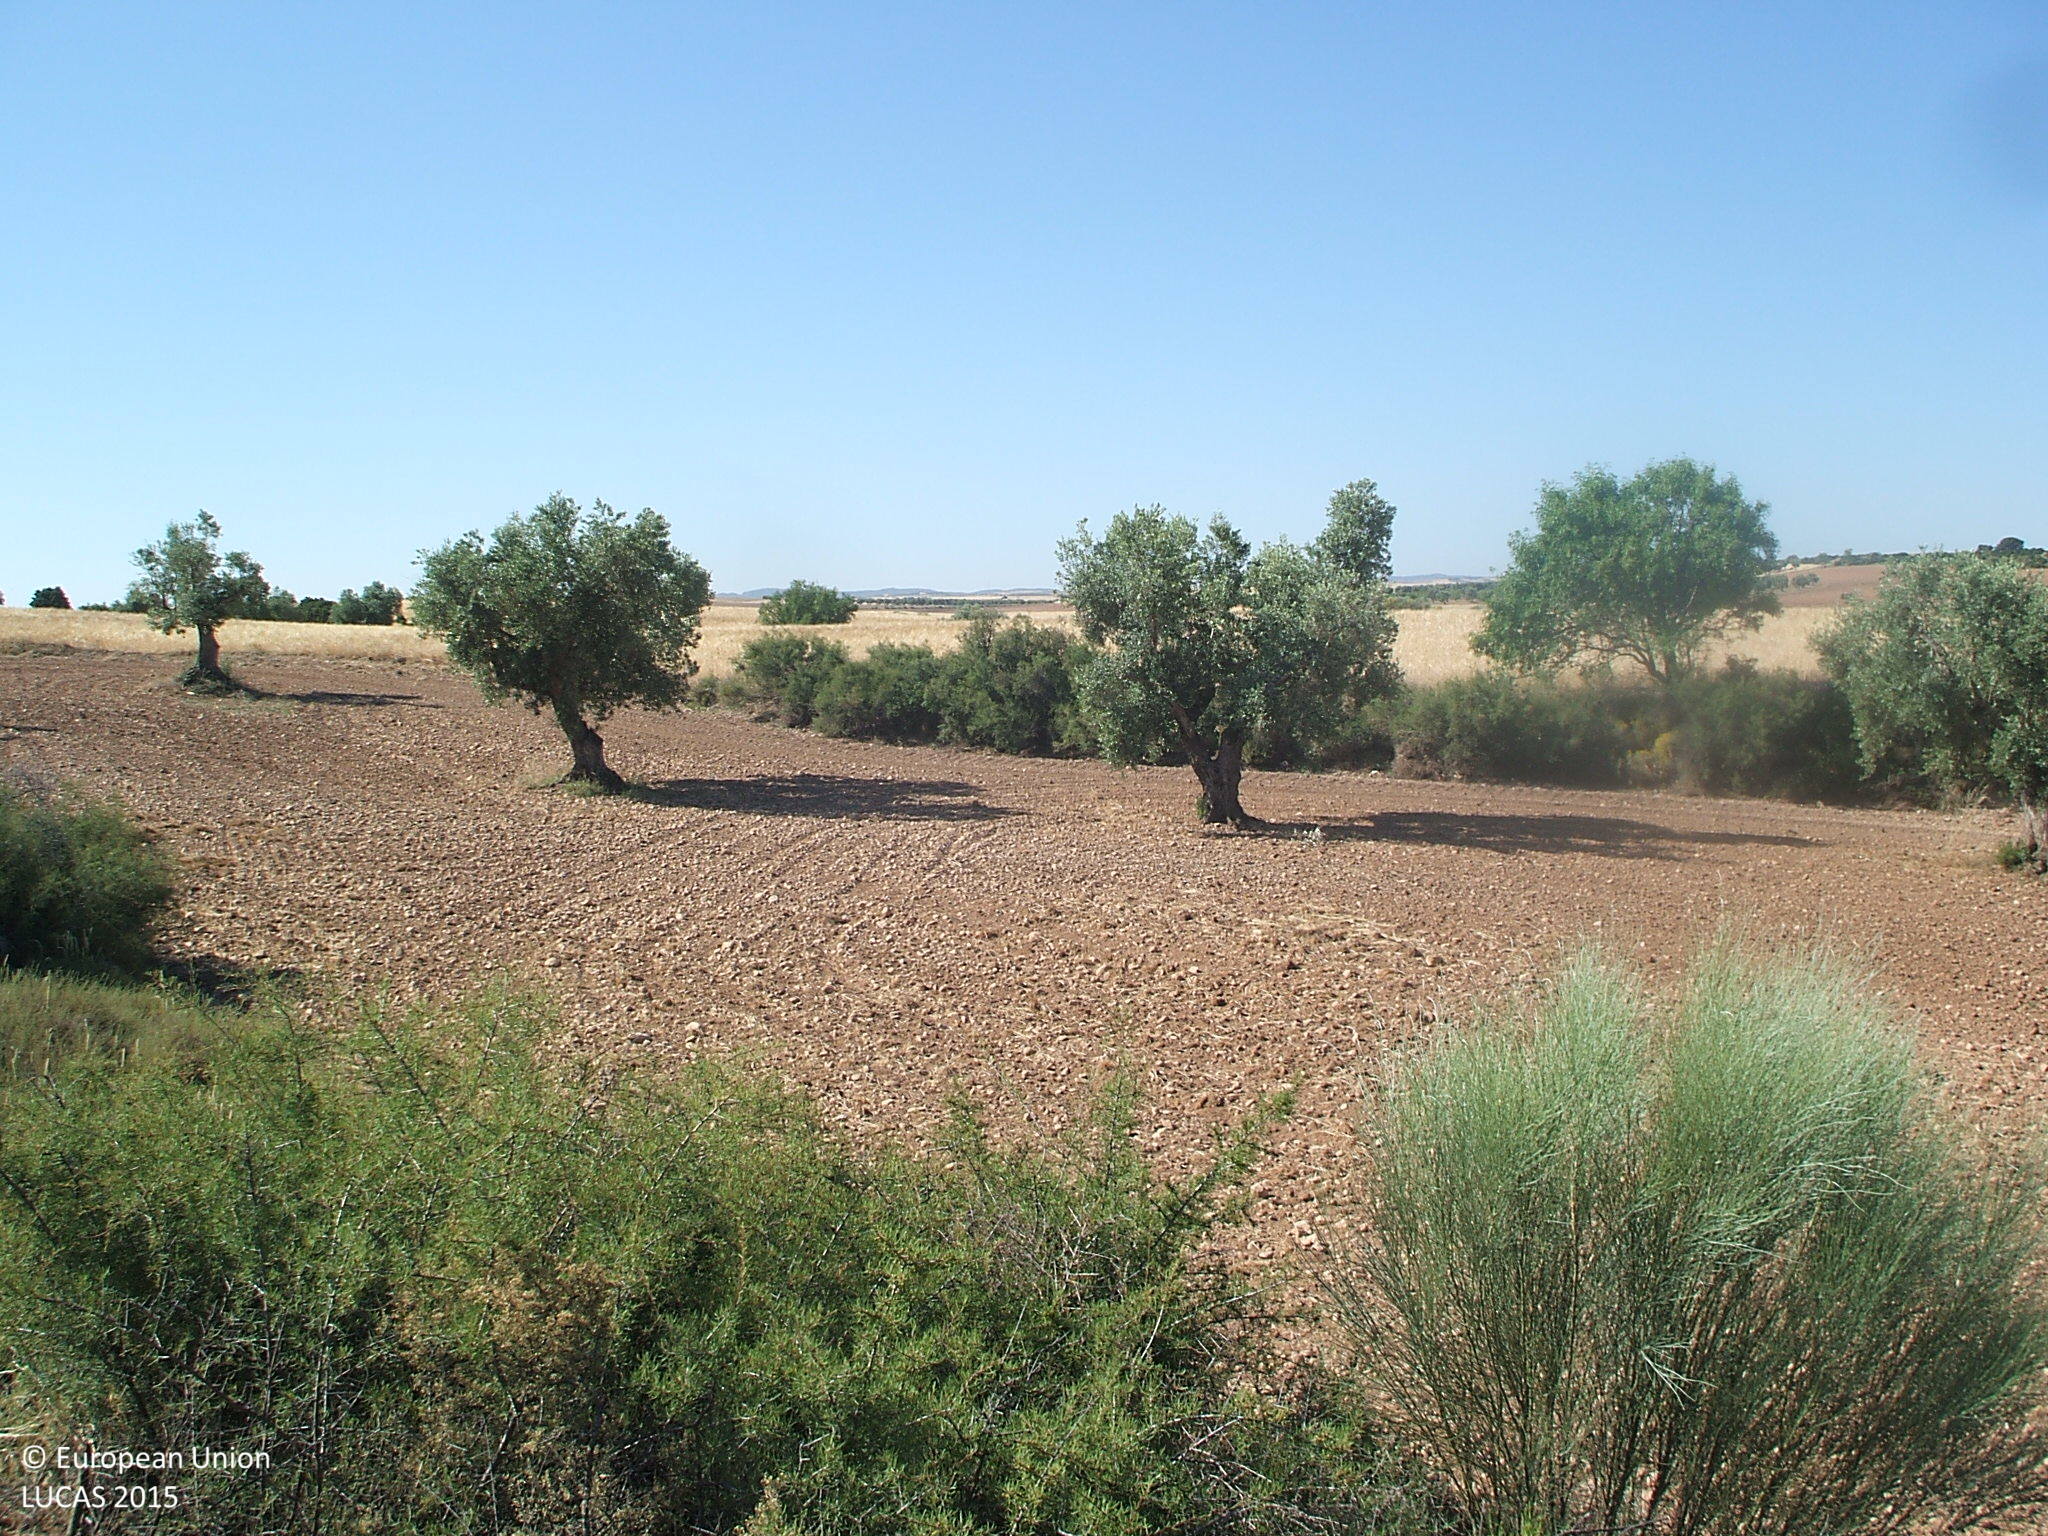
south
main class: Cropland
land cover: Olive groves
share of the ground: 10 - 25 %
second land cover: Other bare soil
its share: > 75 %
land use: Agriculture (excluding fallow land and kitchen gardens)
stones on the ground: > 50 %
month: June
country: ES
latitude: 41.0150
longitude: -0.3218
